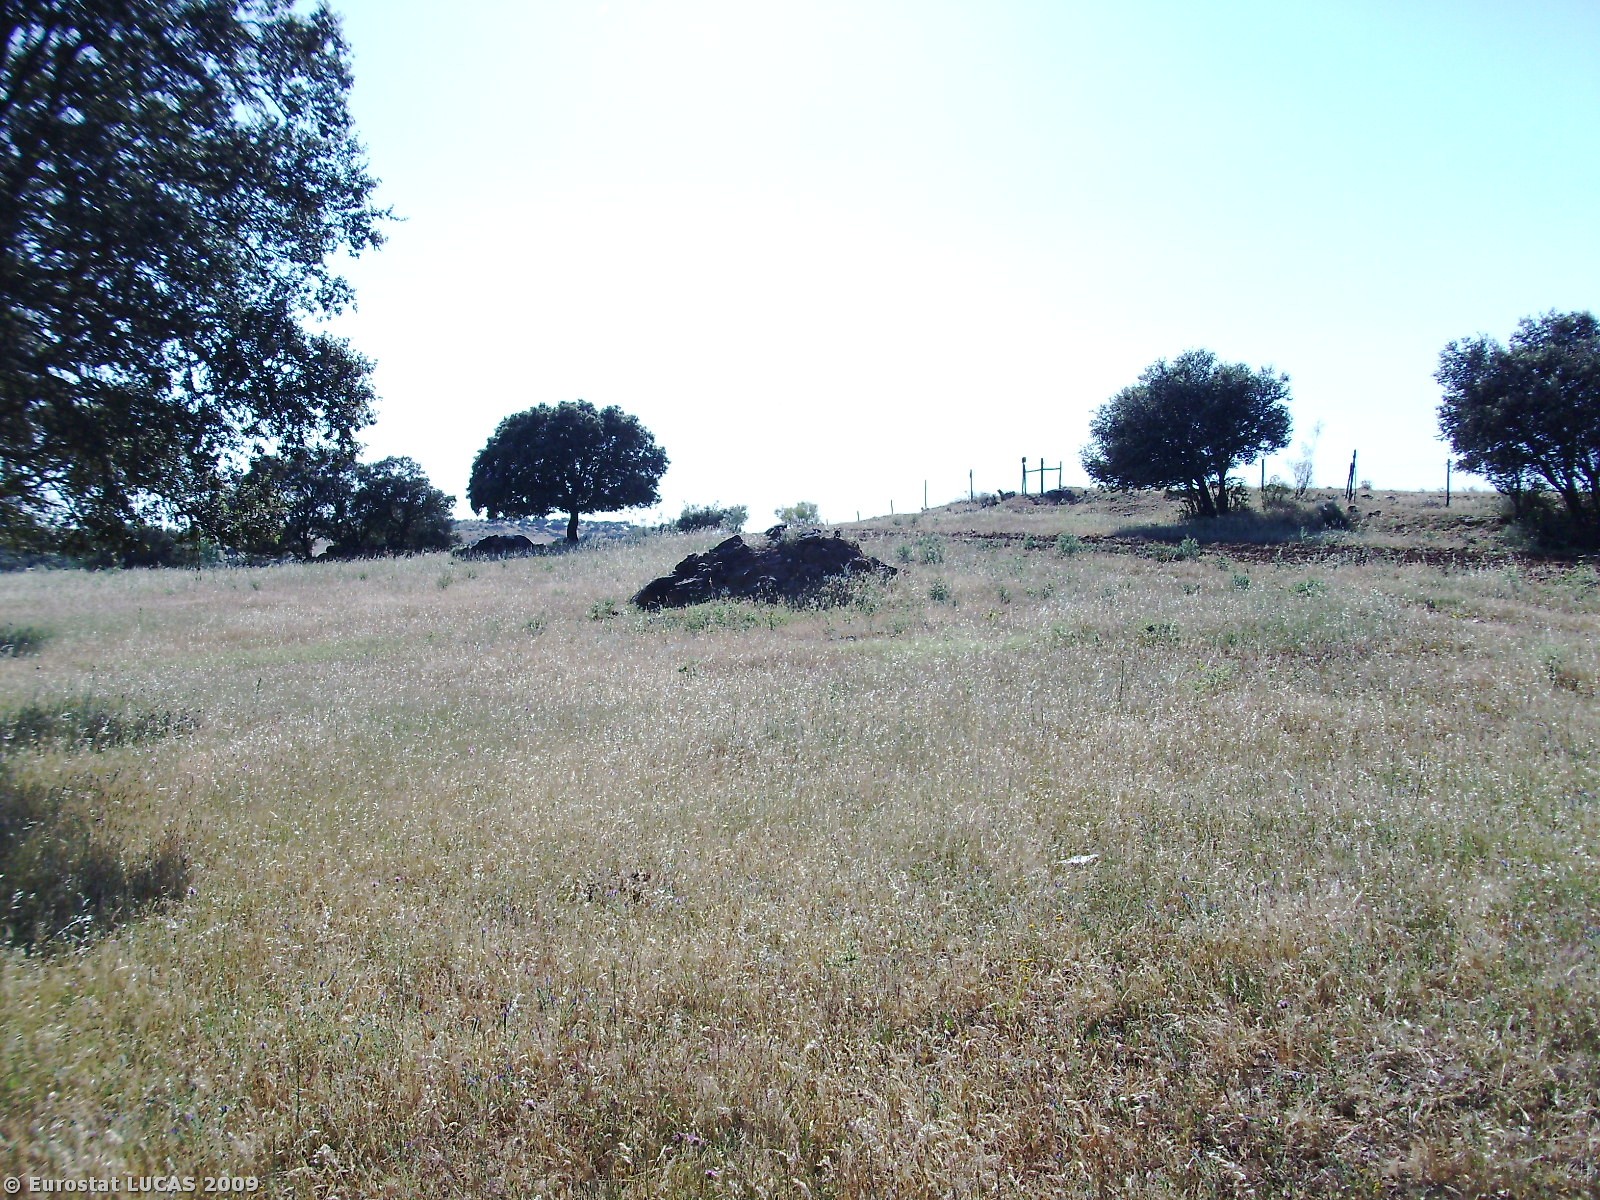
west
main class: Woodland
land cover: Broadleaved woodland
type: broadleaved evergreen forest
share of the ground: 10 - 25 %
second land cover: Grassland with sparse tree/shrub cover
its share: 50 - 75 %
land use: Forestry
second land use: Agriculture (excluding fallow land and kitchen gardens)
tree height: > 5 m
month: May
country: PT
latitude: 38.9612
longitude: -7.3795
